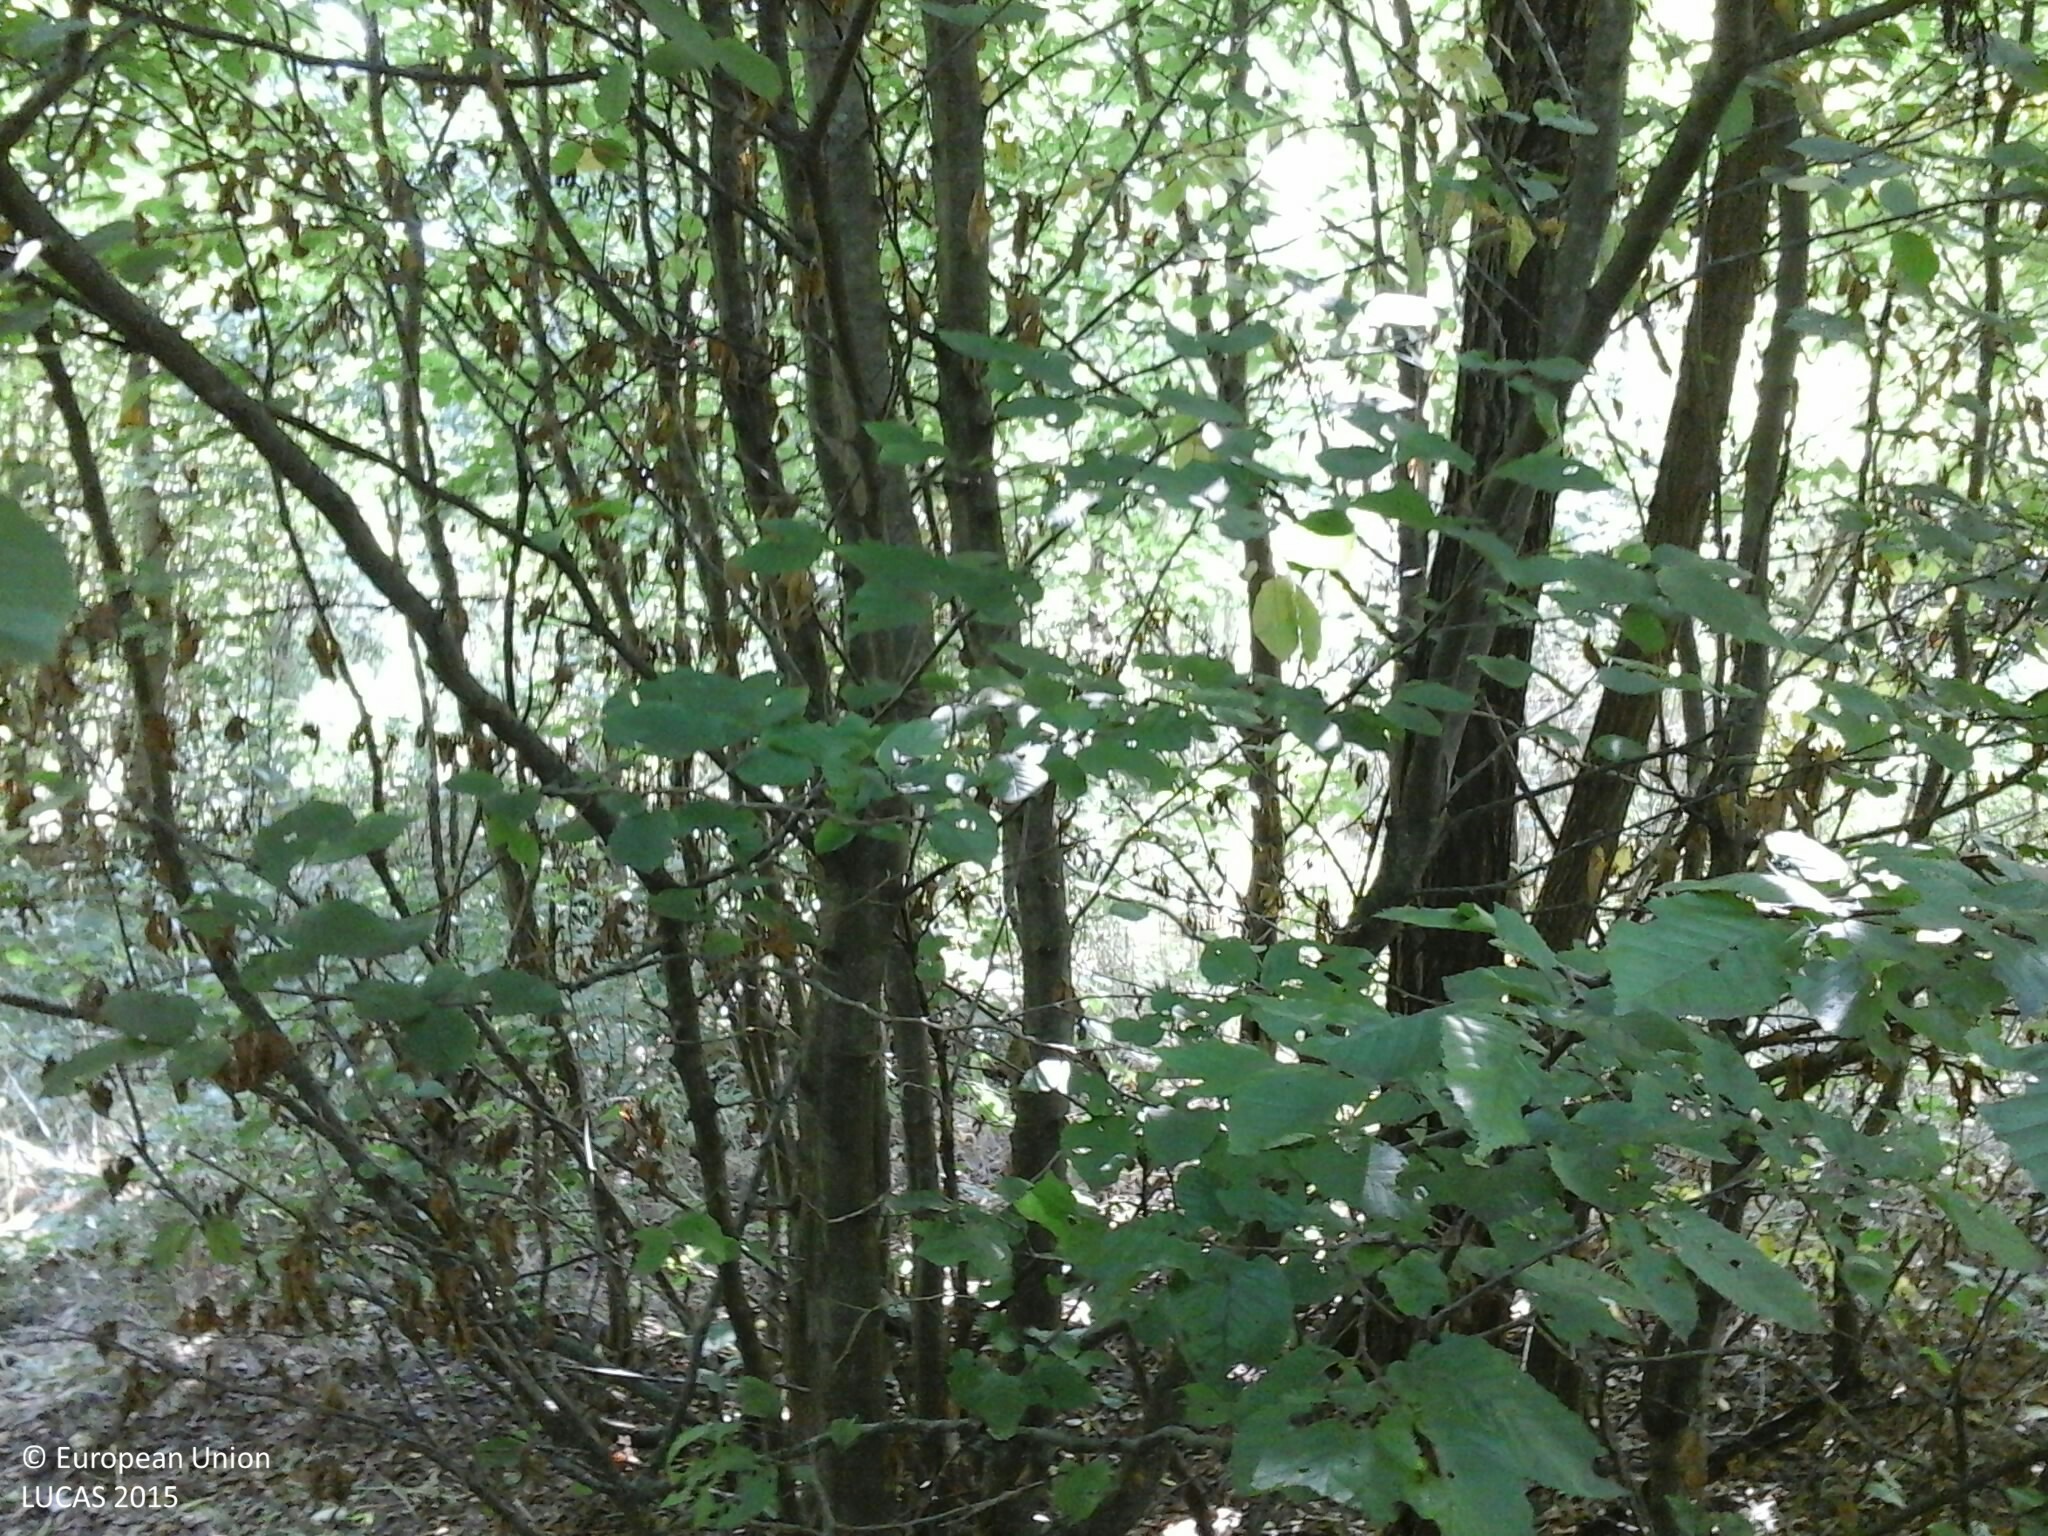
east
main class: Woodland
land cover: Broadleaved woodland
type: beech forest
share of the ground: > 75 %
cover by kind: broadleaved forest trees 80 %, shrubs 10 %, herbaceous plants 10 %
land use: Forestry
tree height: > 5 m
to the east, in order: Broadleaved woodland
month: July
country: HU
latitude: 46.9854
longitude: 16.4842
